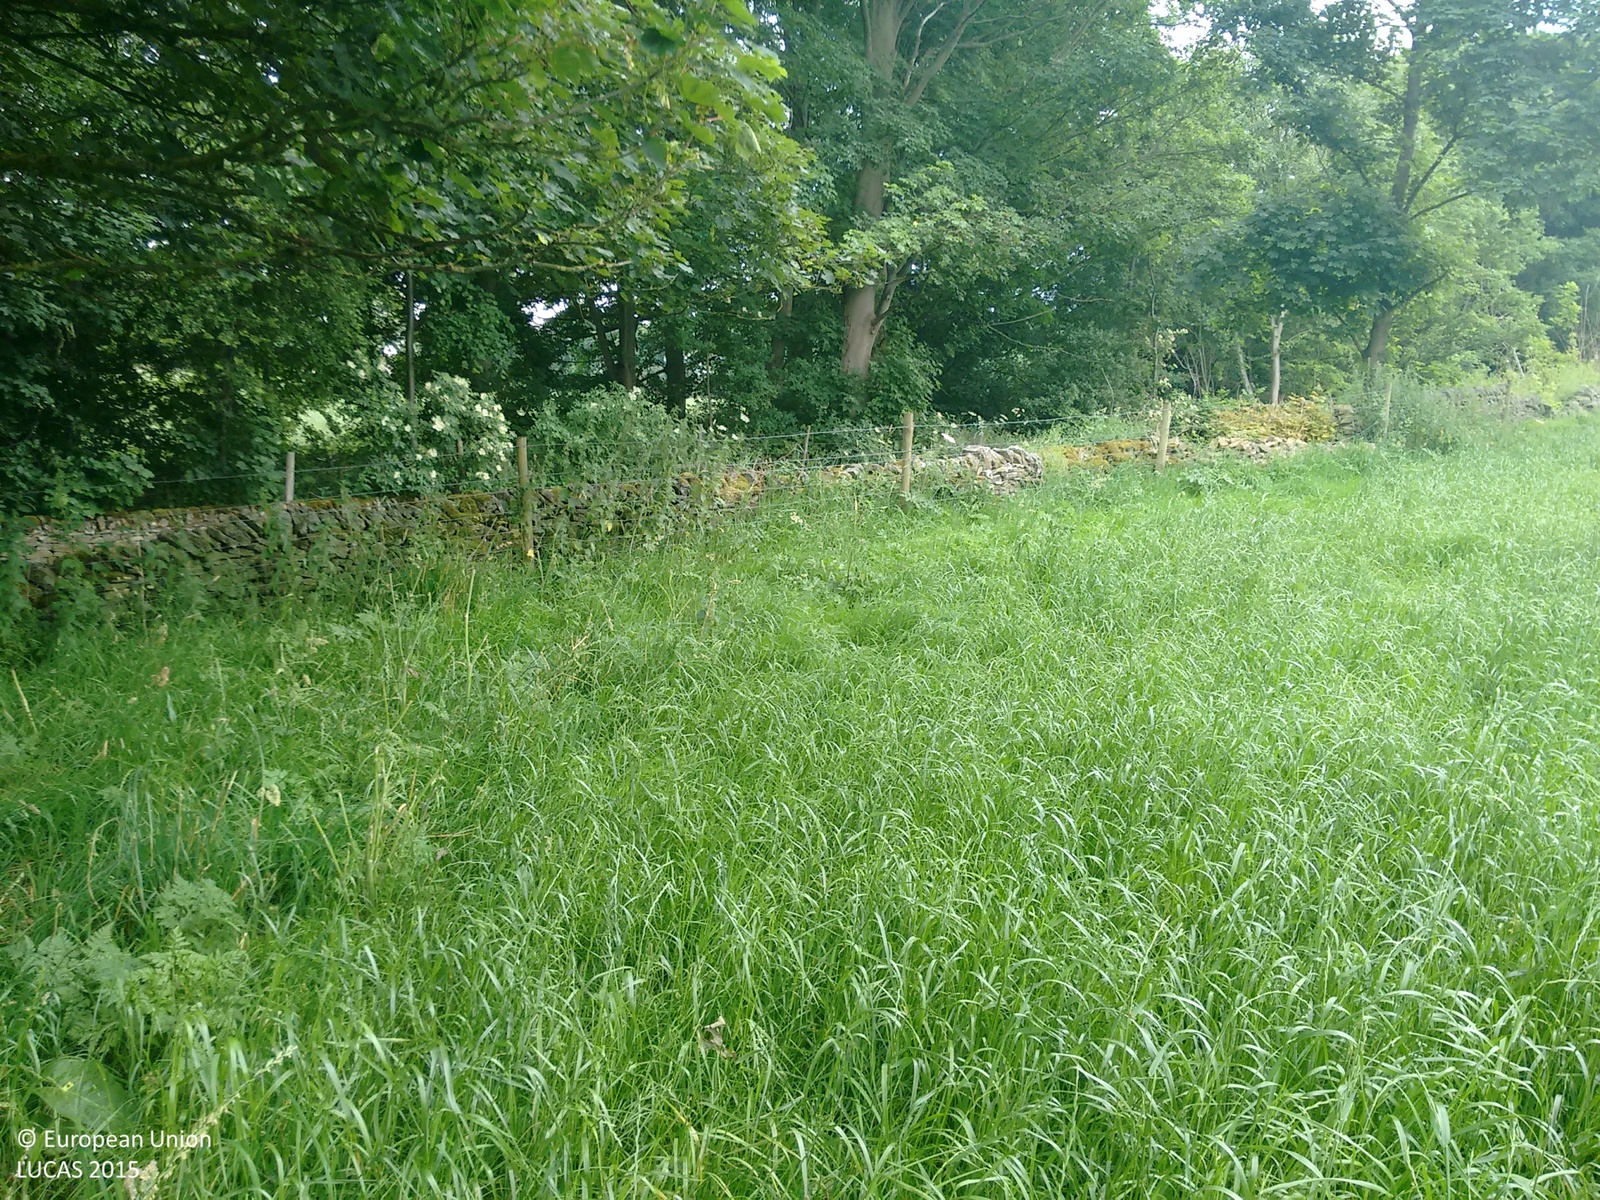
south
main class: Grassland
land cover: Grassland without tree/shrub cover
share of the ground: > 75 %
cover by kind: herbaceous plants 100 %
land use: Agriculture (excluding fallow land and kitchen gardens)
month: July
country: GB
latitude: 53.2387
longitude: -1.6345
